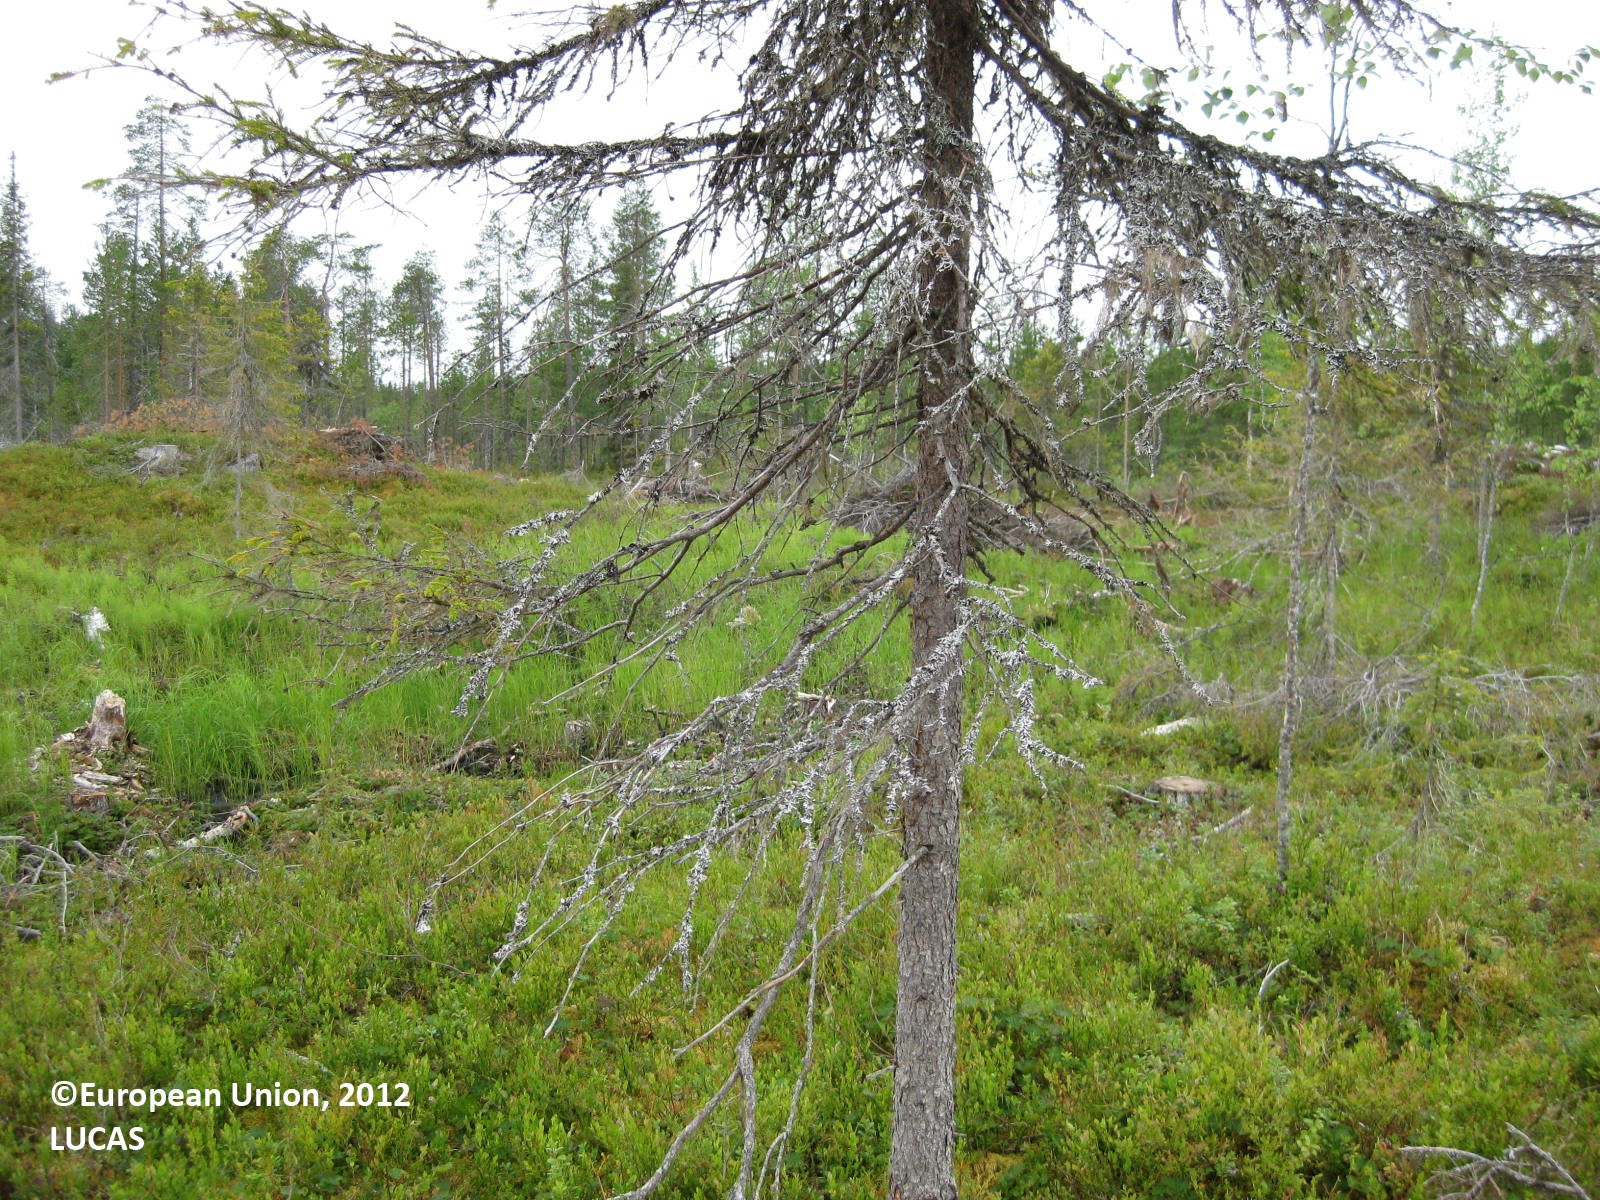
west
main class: Woodland
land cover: Broadleaved woodland
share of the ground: 10 - 25 %
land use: Forestry
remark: Clear cut
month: July
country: FI
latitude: 65.8618
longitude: 29.7277
